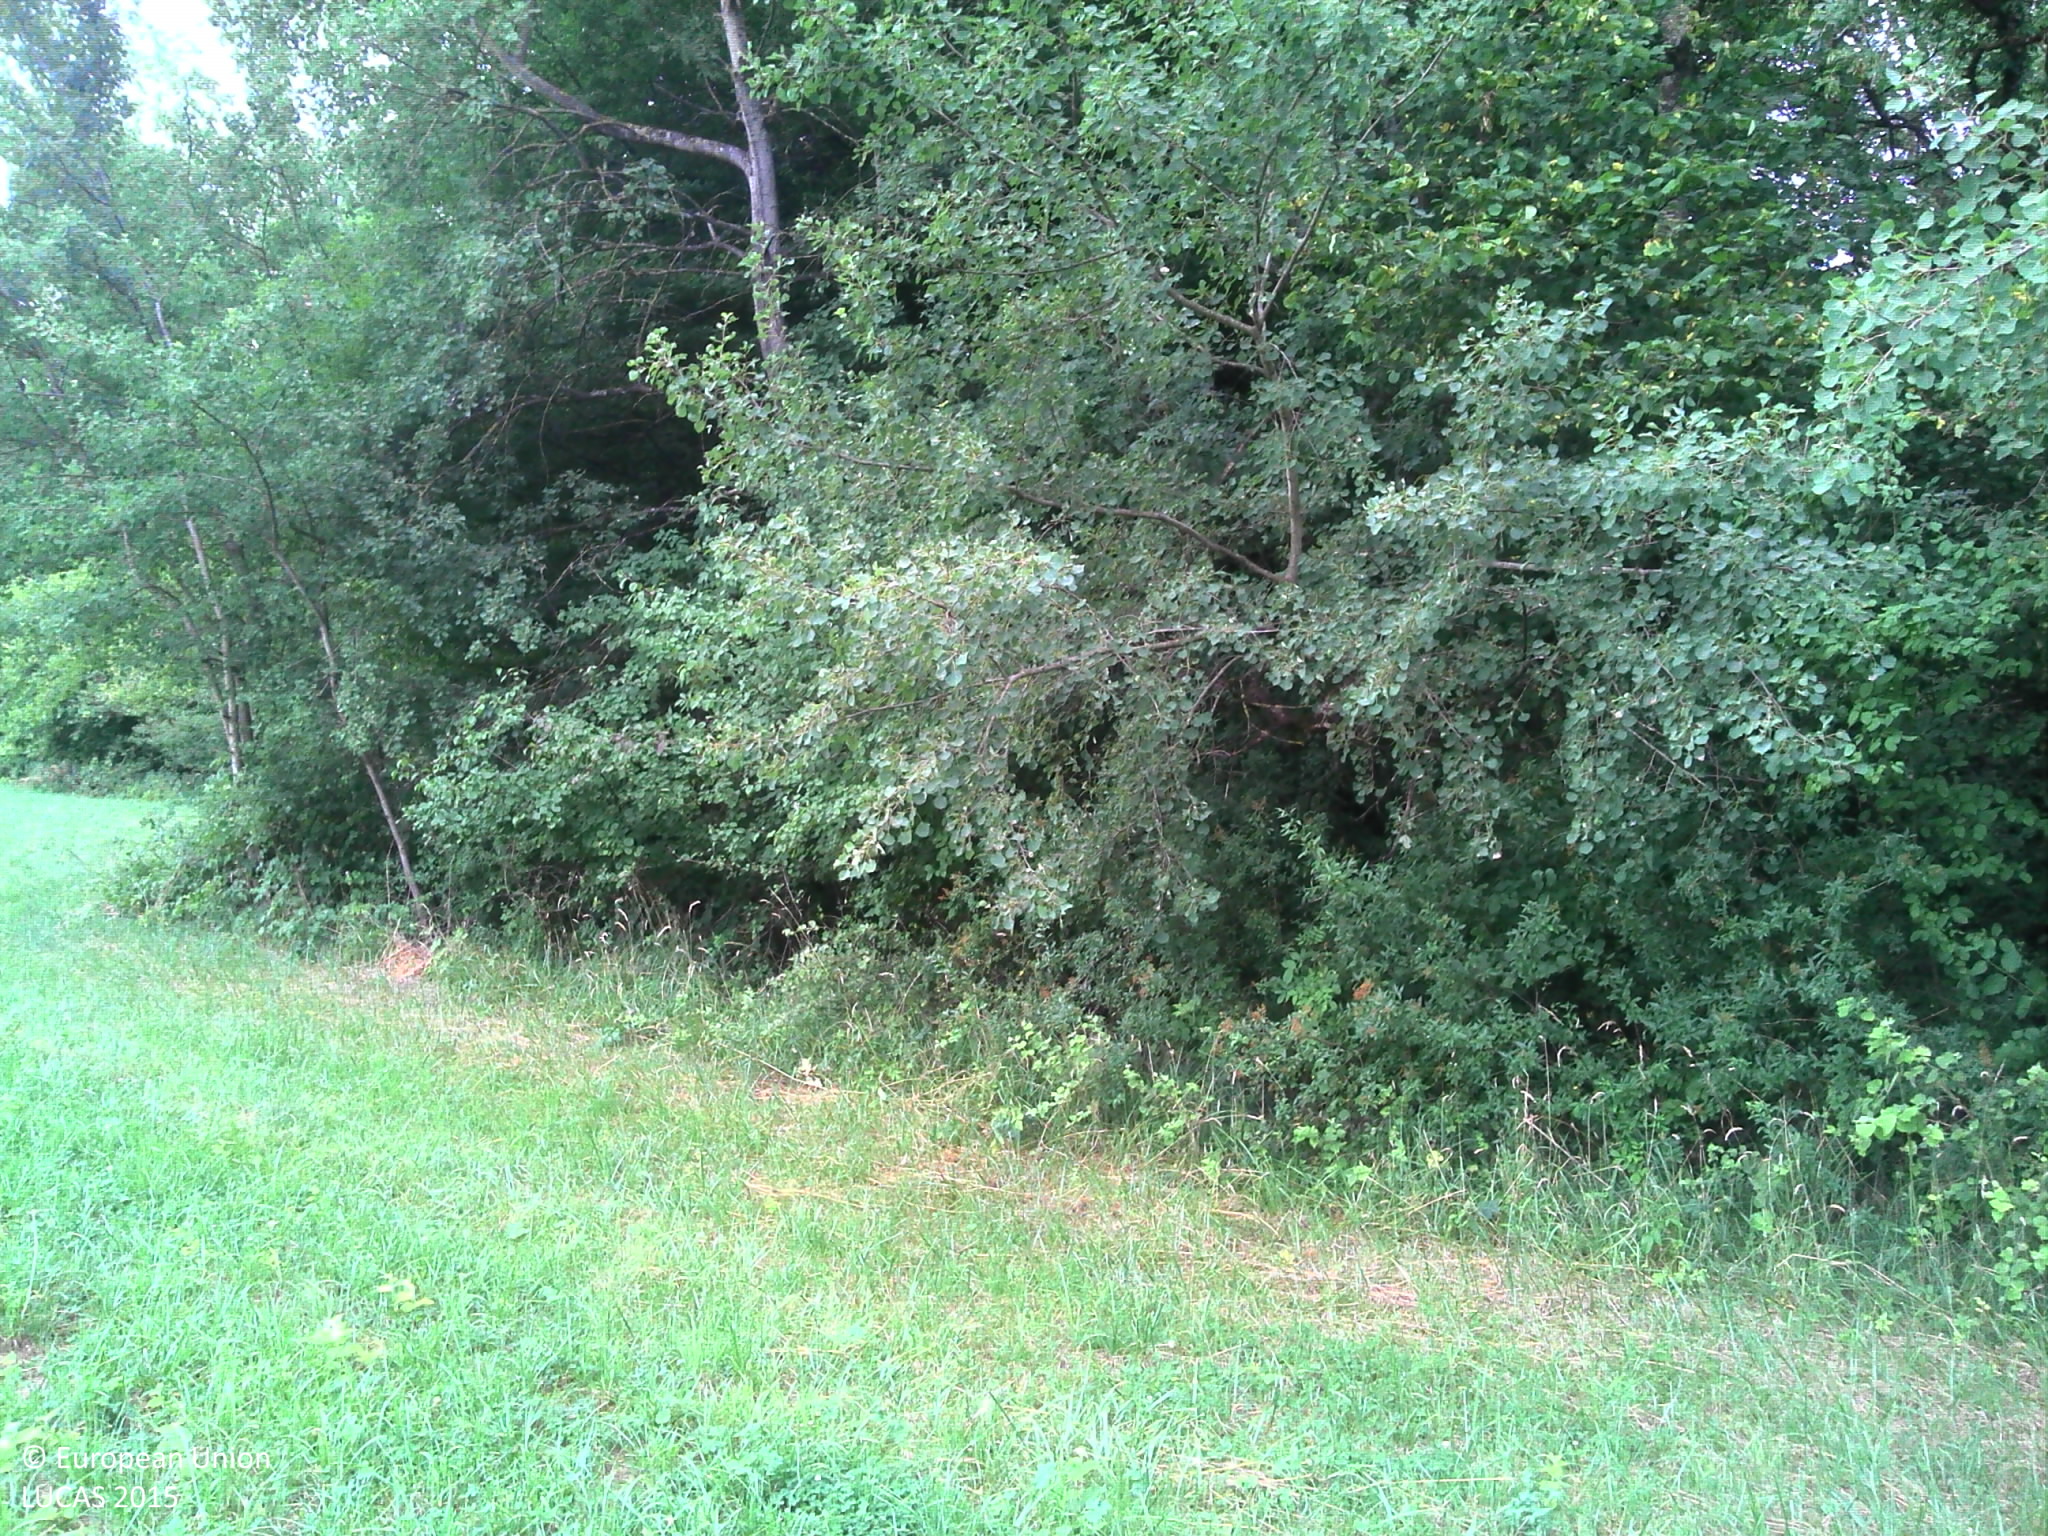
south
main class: Grassland
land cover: Grassland without tree/shrub cover
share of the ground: > 75 %
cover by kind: herbaceous plants 100 %
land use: Agriculture (excluding fallow land and kitchen gardens)
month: July
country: FR
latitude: 46.2514
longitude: 6.3066
